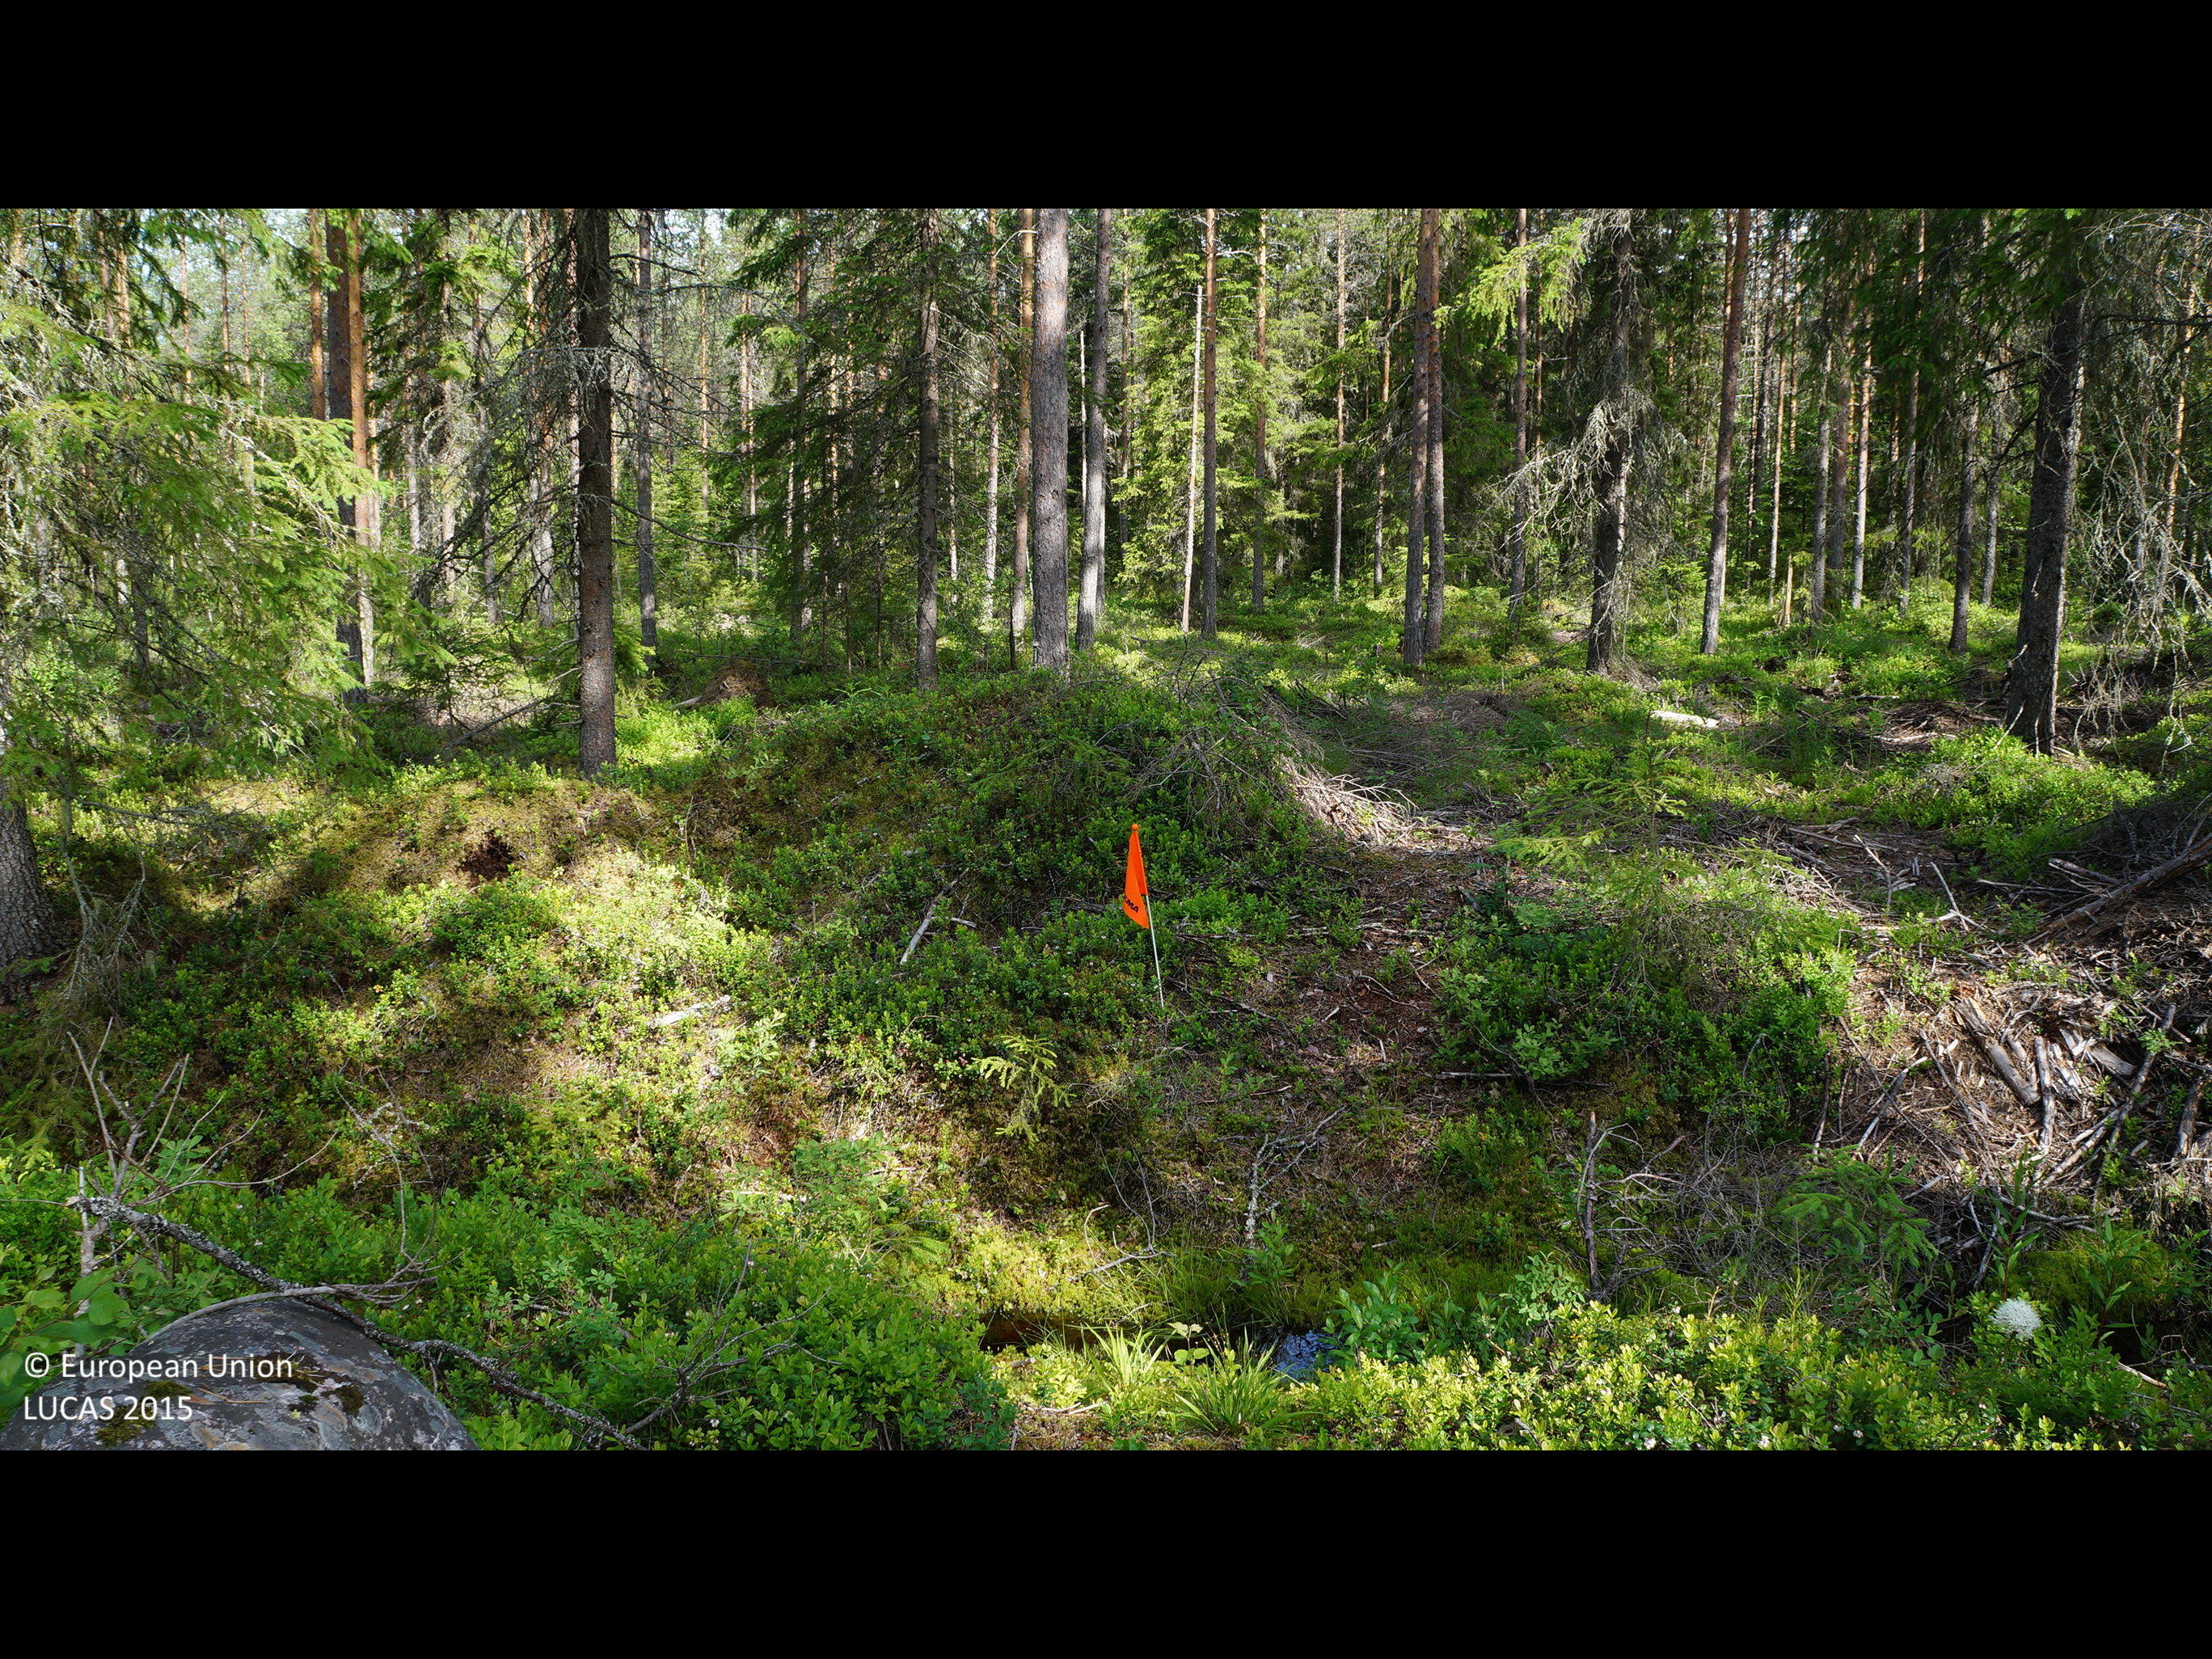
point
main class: Woodland
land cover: Spruce dominated coniferous woodland
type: boreal forest
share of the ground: 50 - 75 %
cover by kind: coniferous forest trees 50 %, shrubs 35 %, lichens and mosses 10 %, broadleaved forest trees 5 %
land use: Forestry
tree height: > 5 m
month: July
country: FI
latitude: 64.3462
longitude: 24.5847
